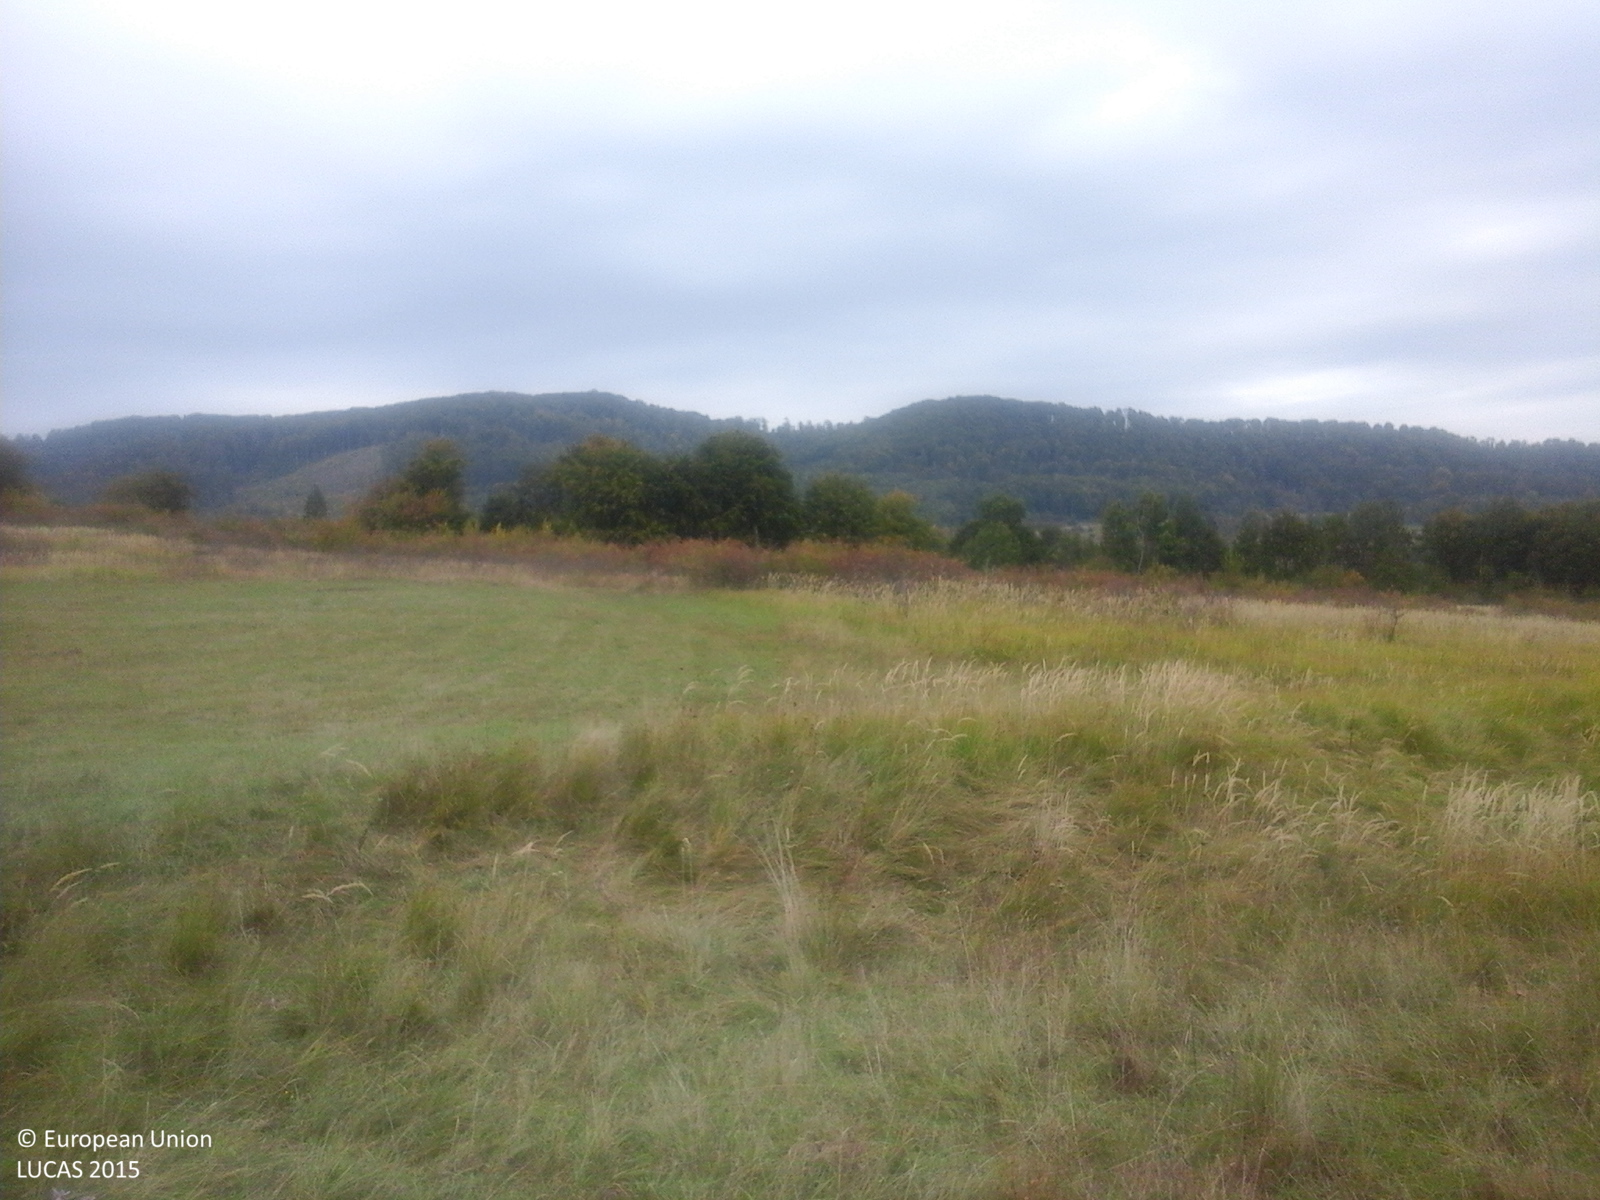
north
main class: Grassland
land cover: Grassland without tree/shrub cover
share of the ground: > 75 %
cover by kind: herbaceous plants 100 %
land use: Agriculture (excluding fallow land and kitchen gardens)
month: October
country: RO
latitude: 46.5836
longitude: 25.0148
